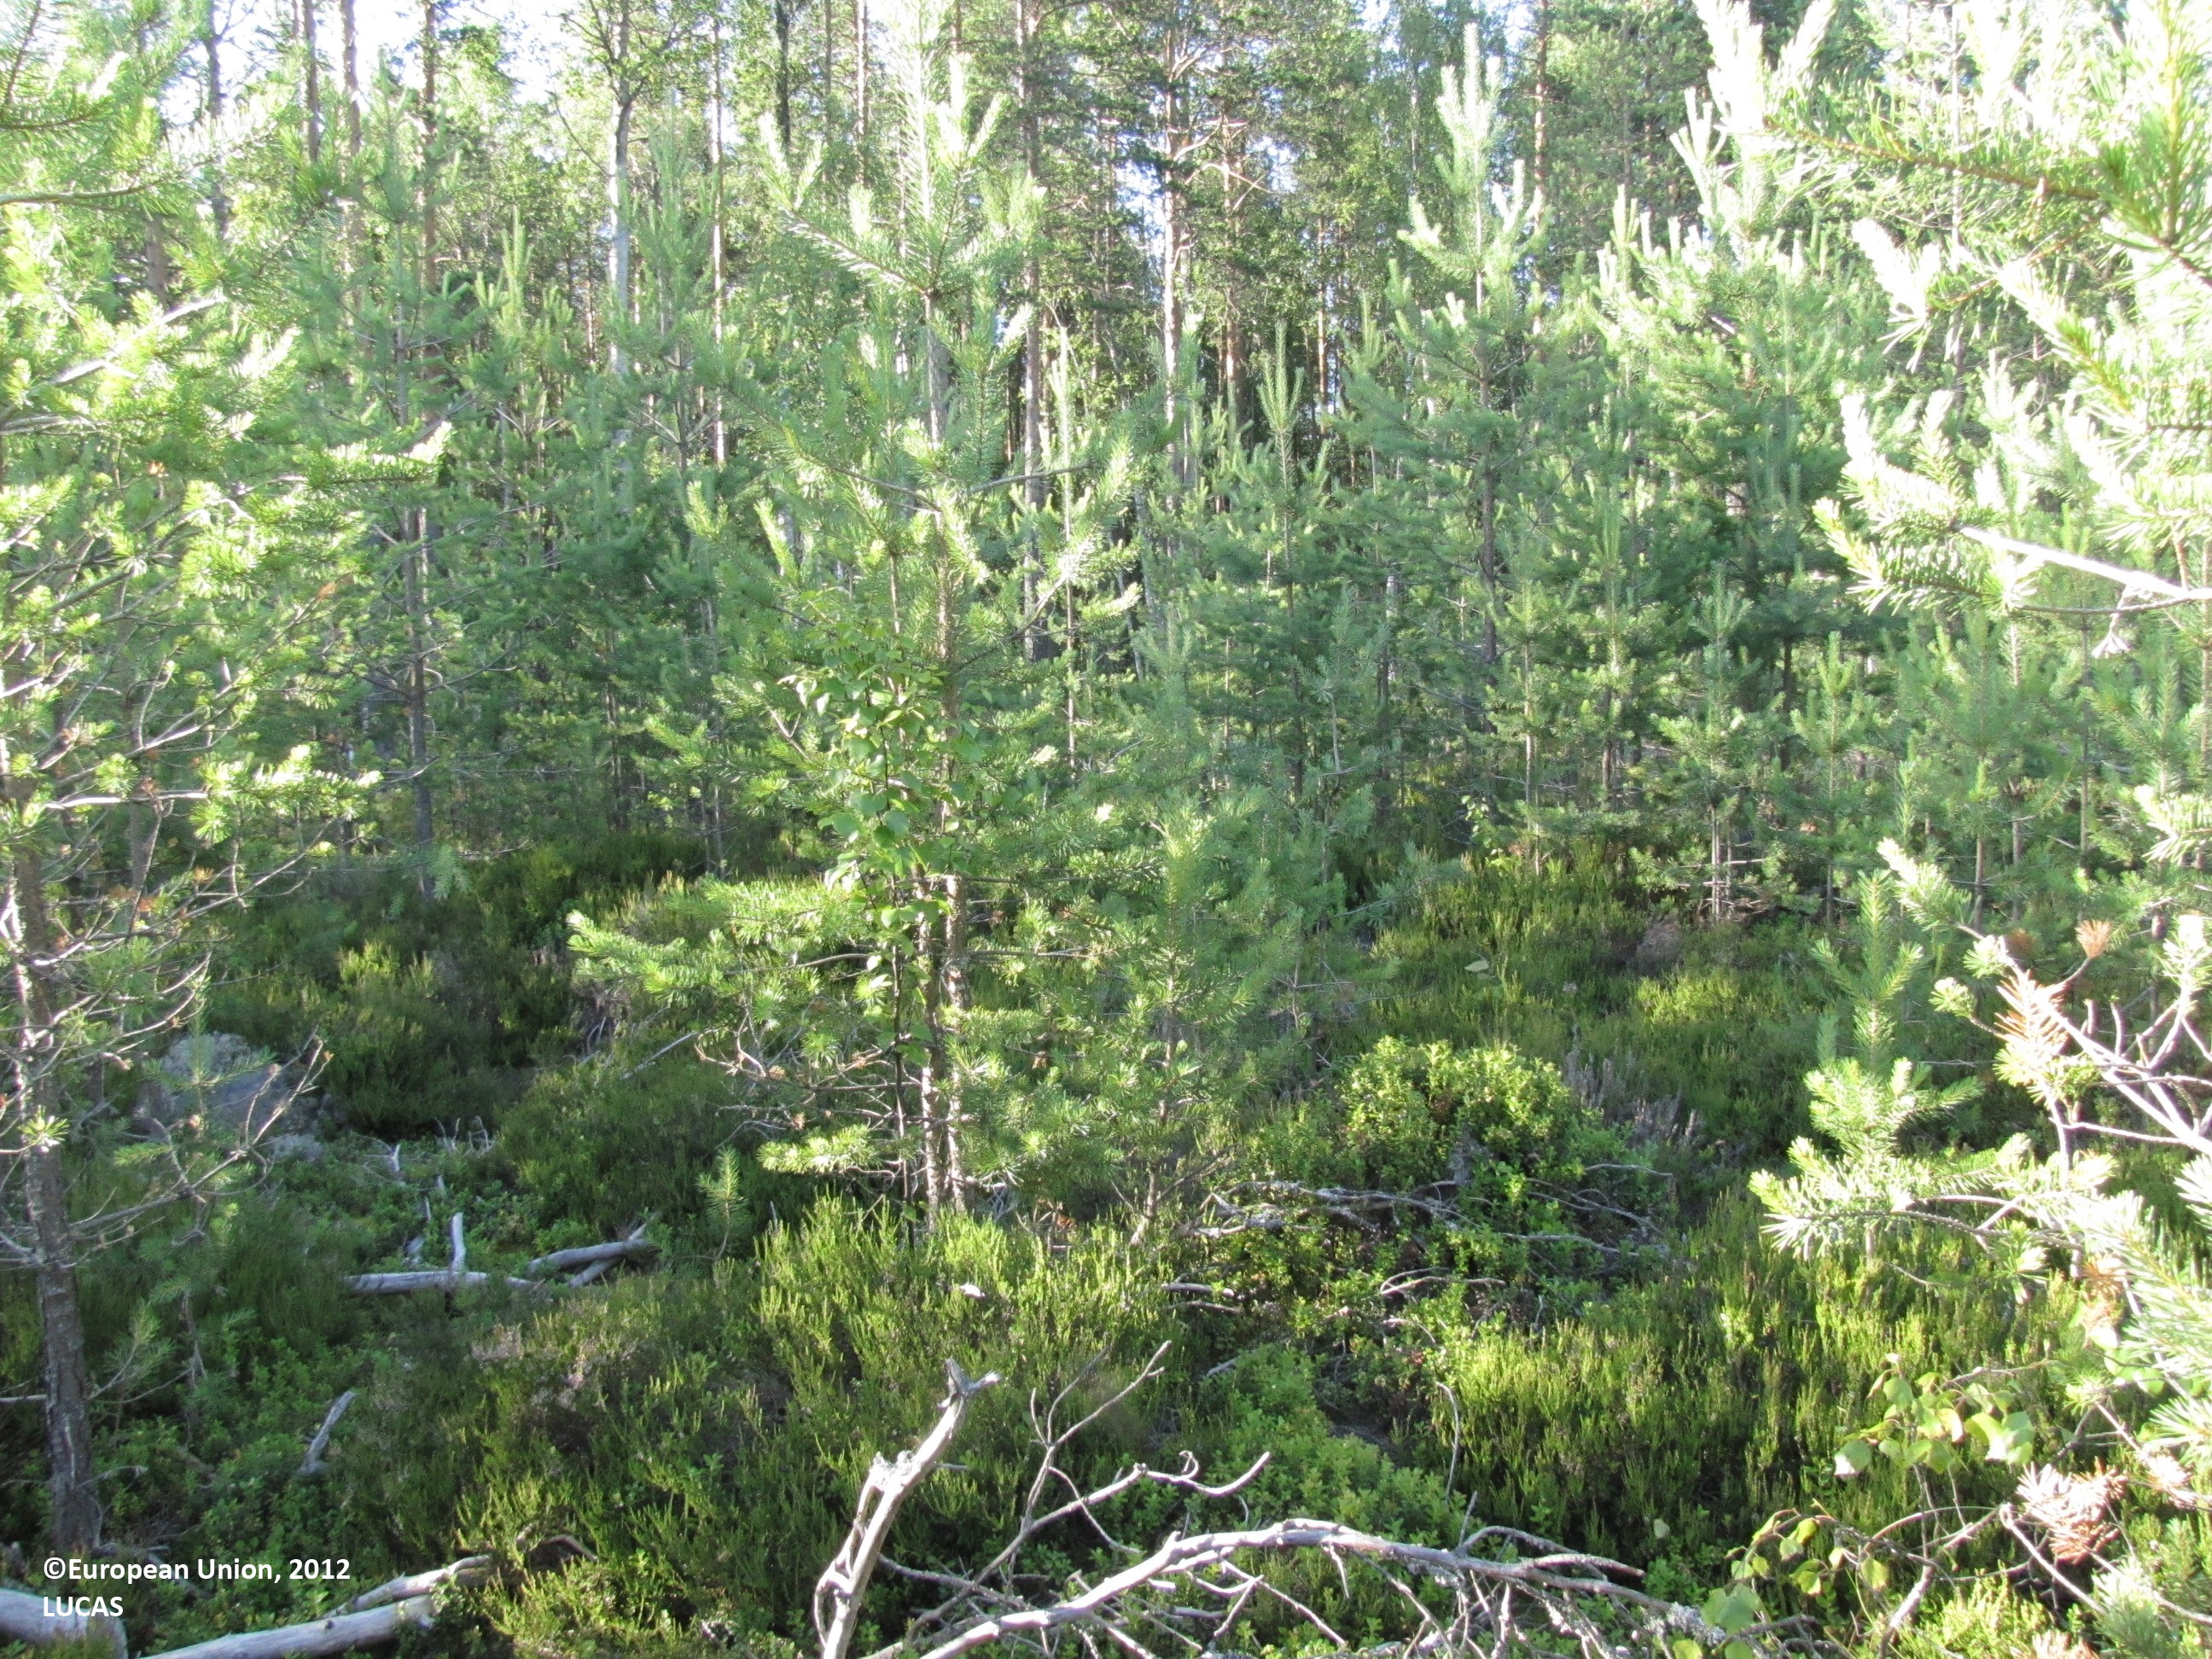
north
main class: Woodland
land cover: Pine dominated coniferous woodland
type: boreal forest
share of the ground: 25 - 50 %
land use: Forestry
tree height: > 5 m
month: July
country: FI
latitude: 62.5213
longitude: 23.2179
